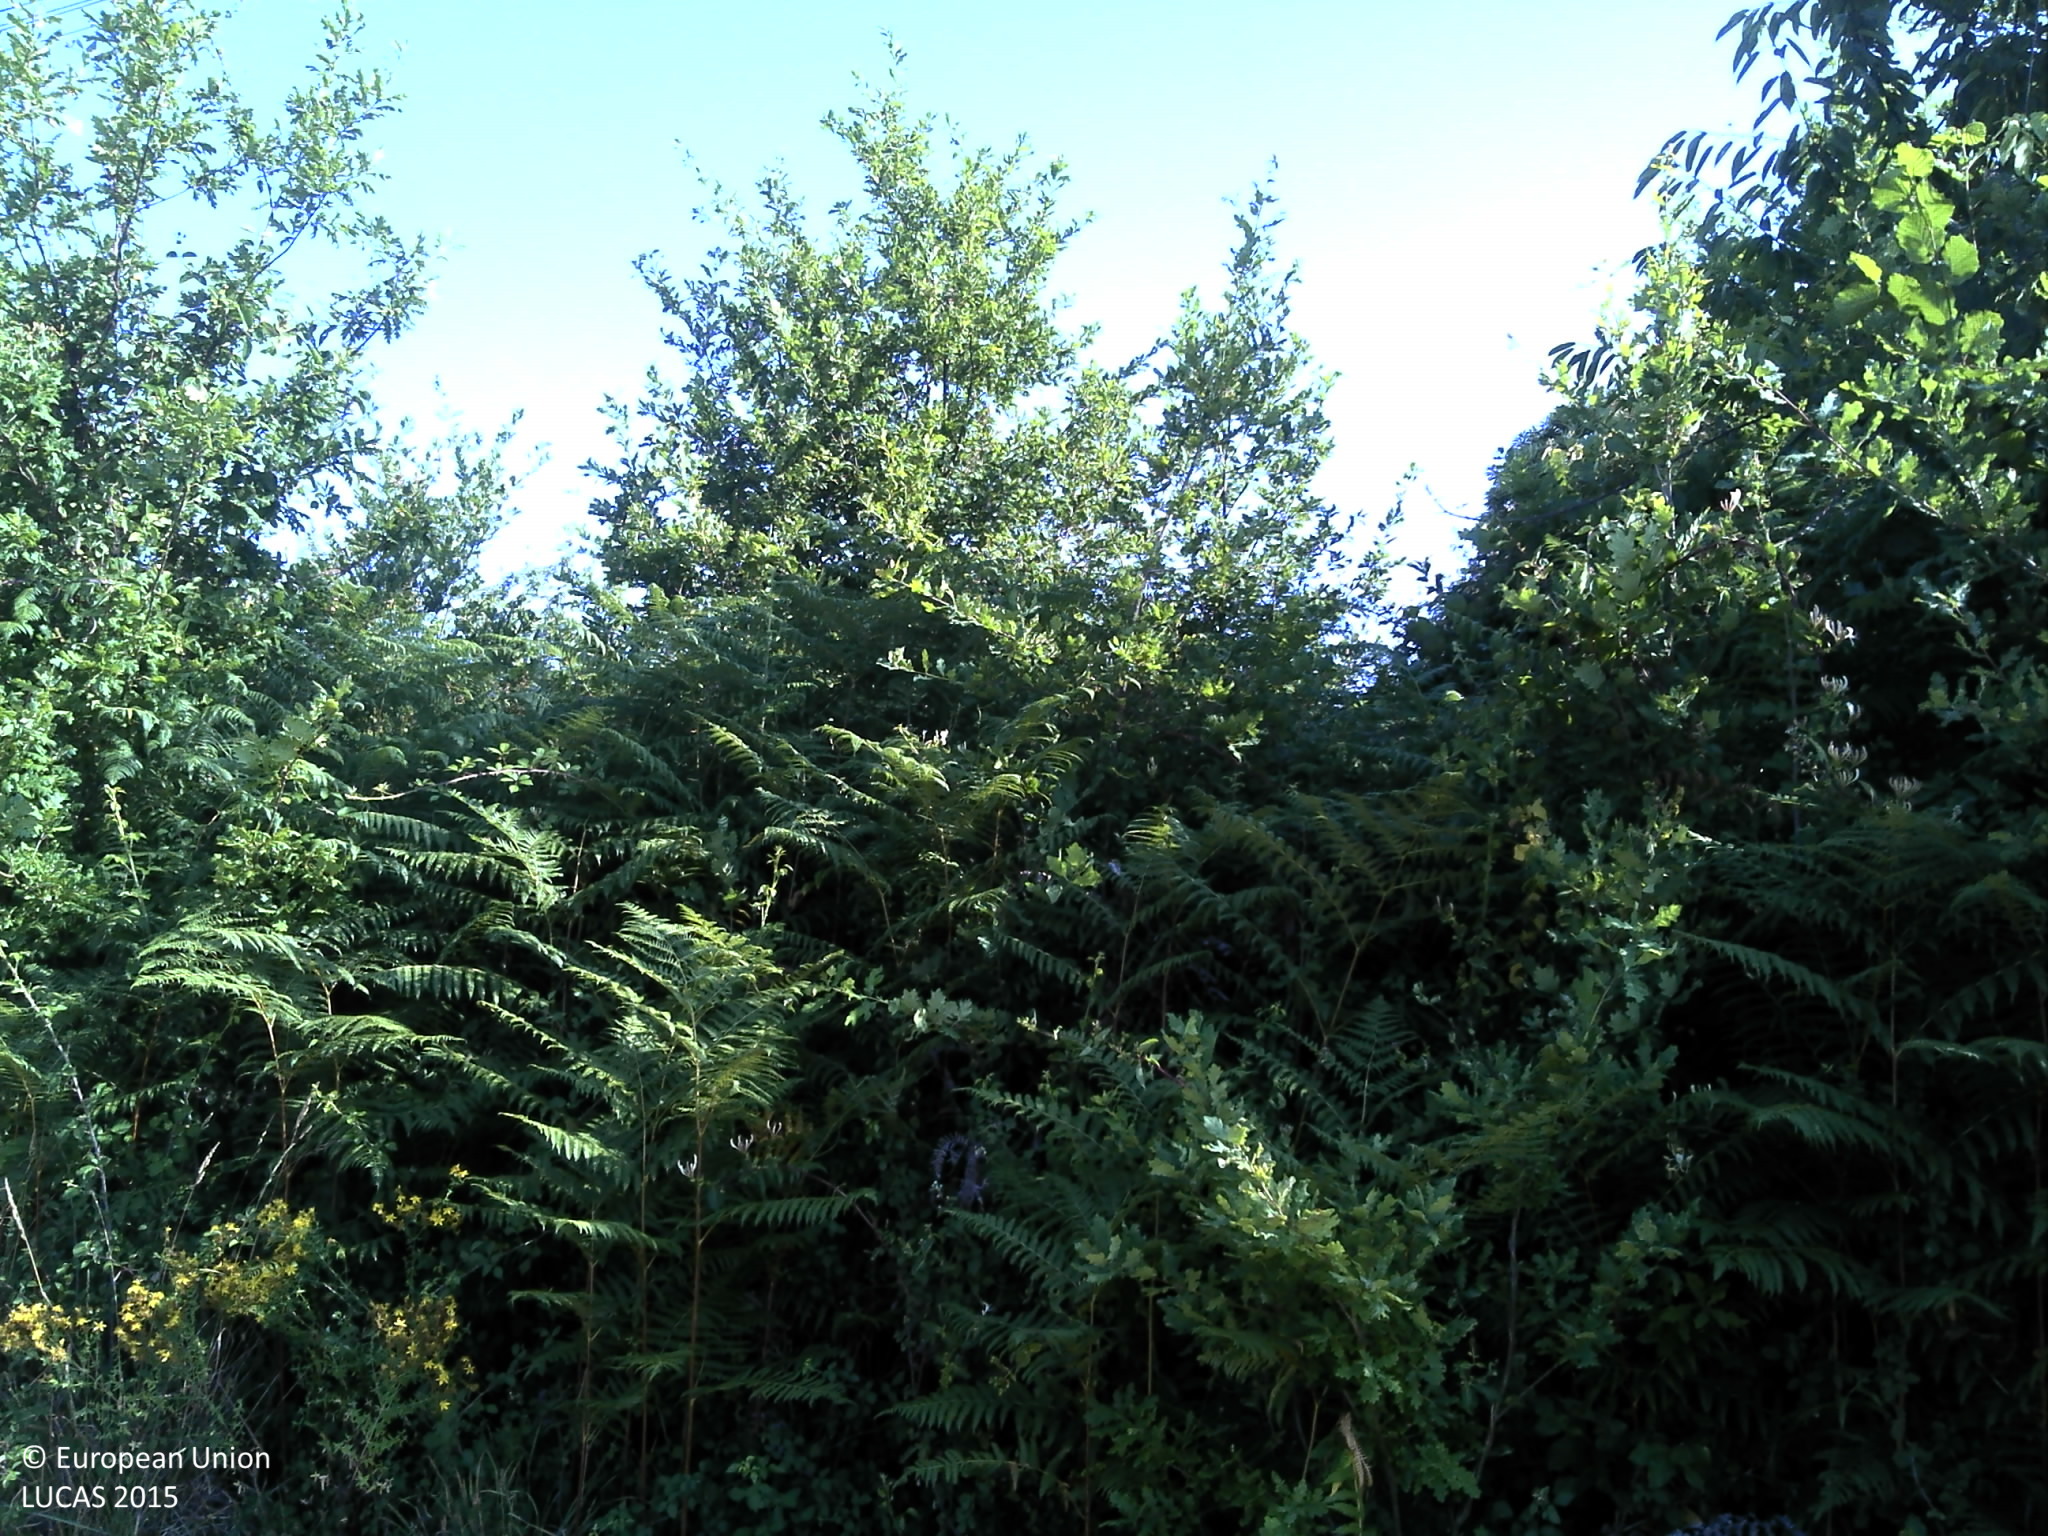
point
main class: Shrubland
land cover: Shrubland with sparse tree cover
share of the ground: > 75 %
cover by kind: shrubs 95 %, broadleaved forest trees 5 %
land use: Semi-natural and natural areas not in use
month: July
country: PT
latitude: 40.8177
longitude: -7.8256
